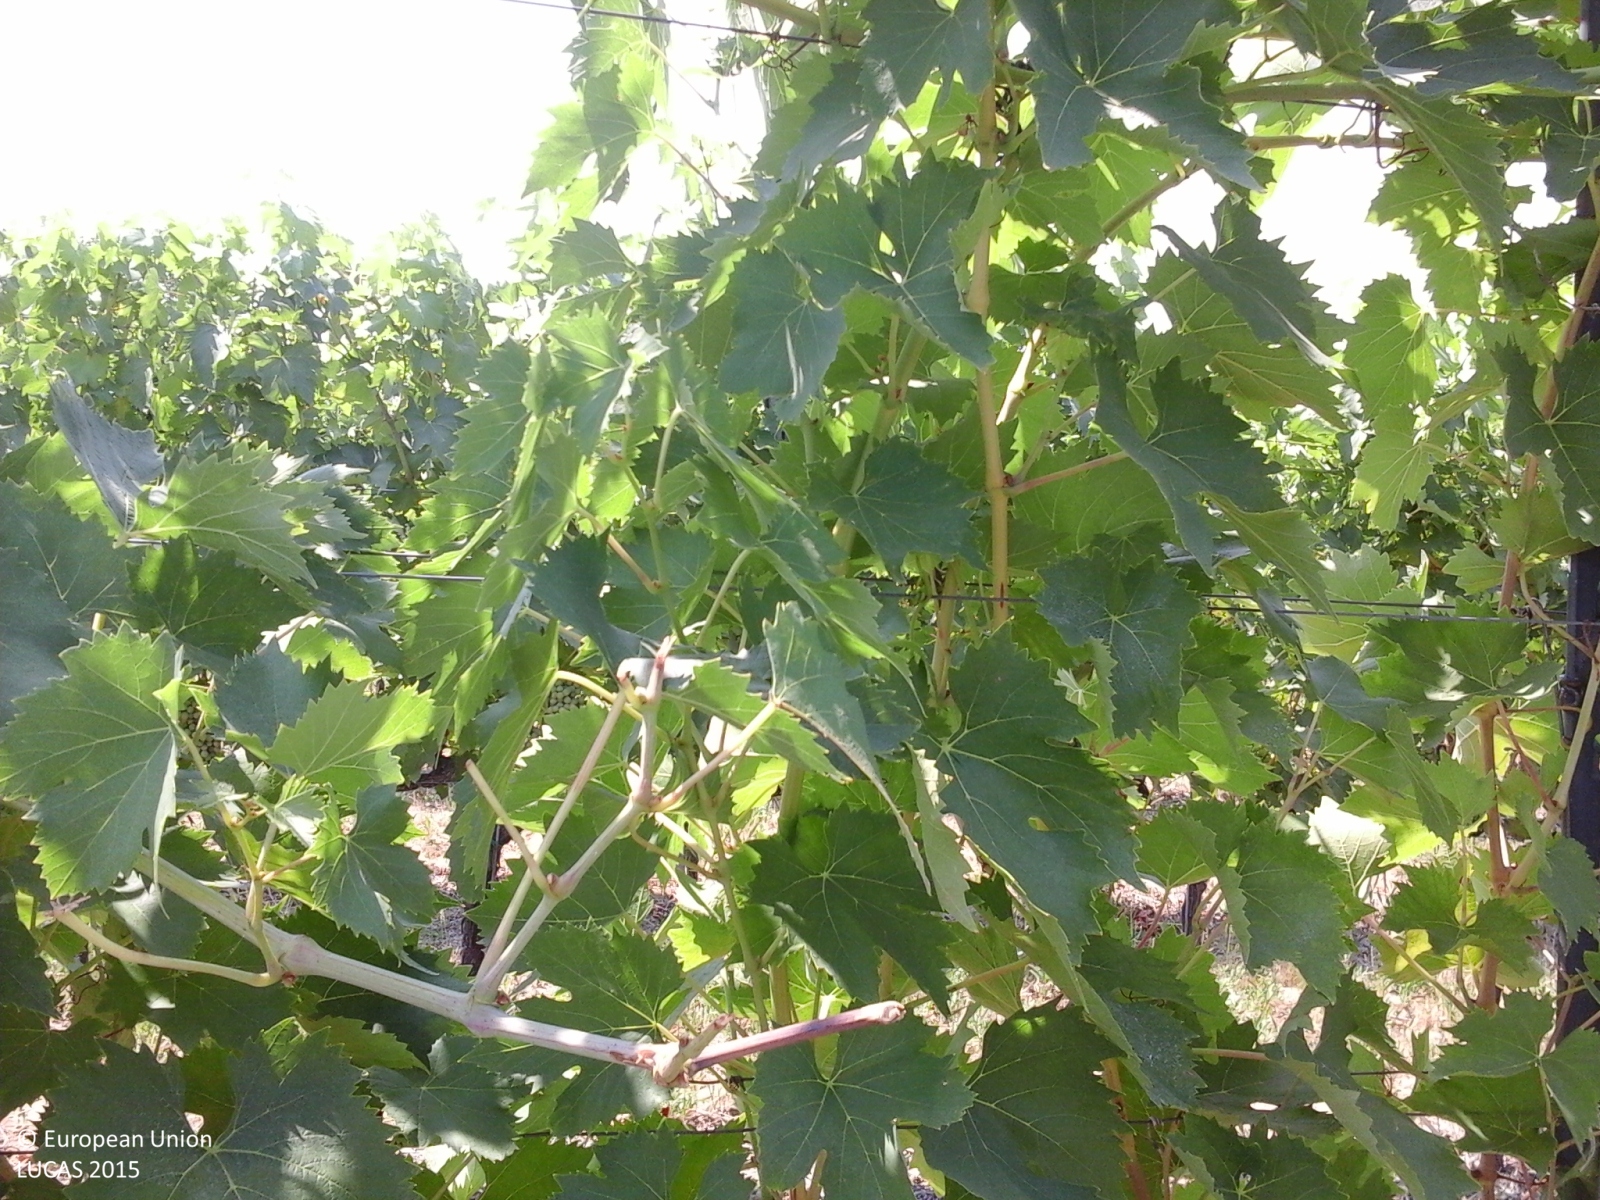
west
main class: Cropland
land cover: Vineyards
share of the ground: > 75 %
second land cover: Grassland without tree/shrub cover
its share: > 75 %
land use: Agriculture (excluding fallow land and kitchen gardens)
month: July
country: IT
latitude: 44.0707
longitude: 12.3793
